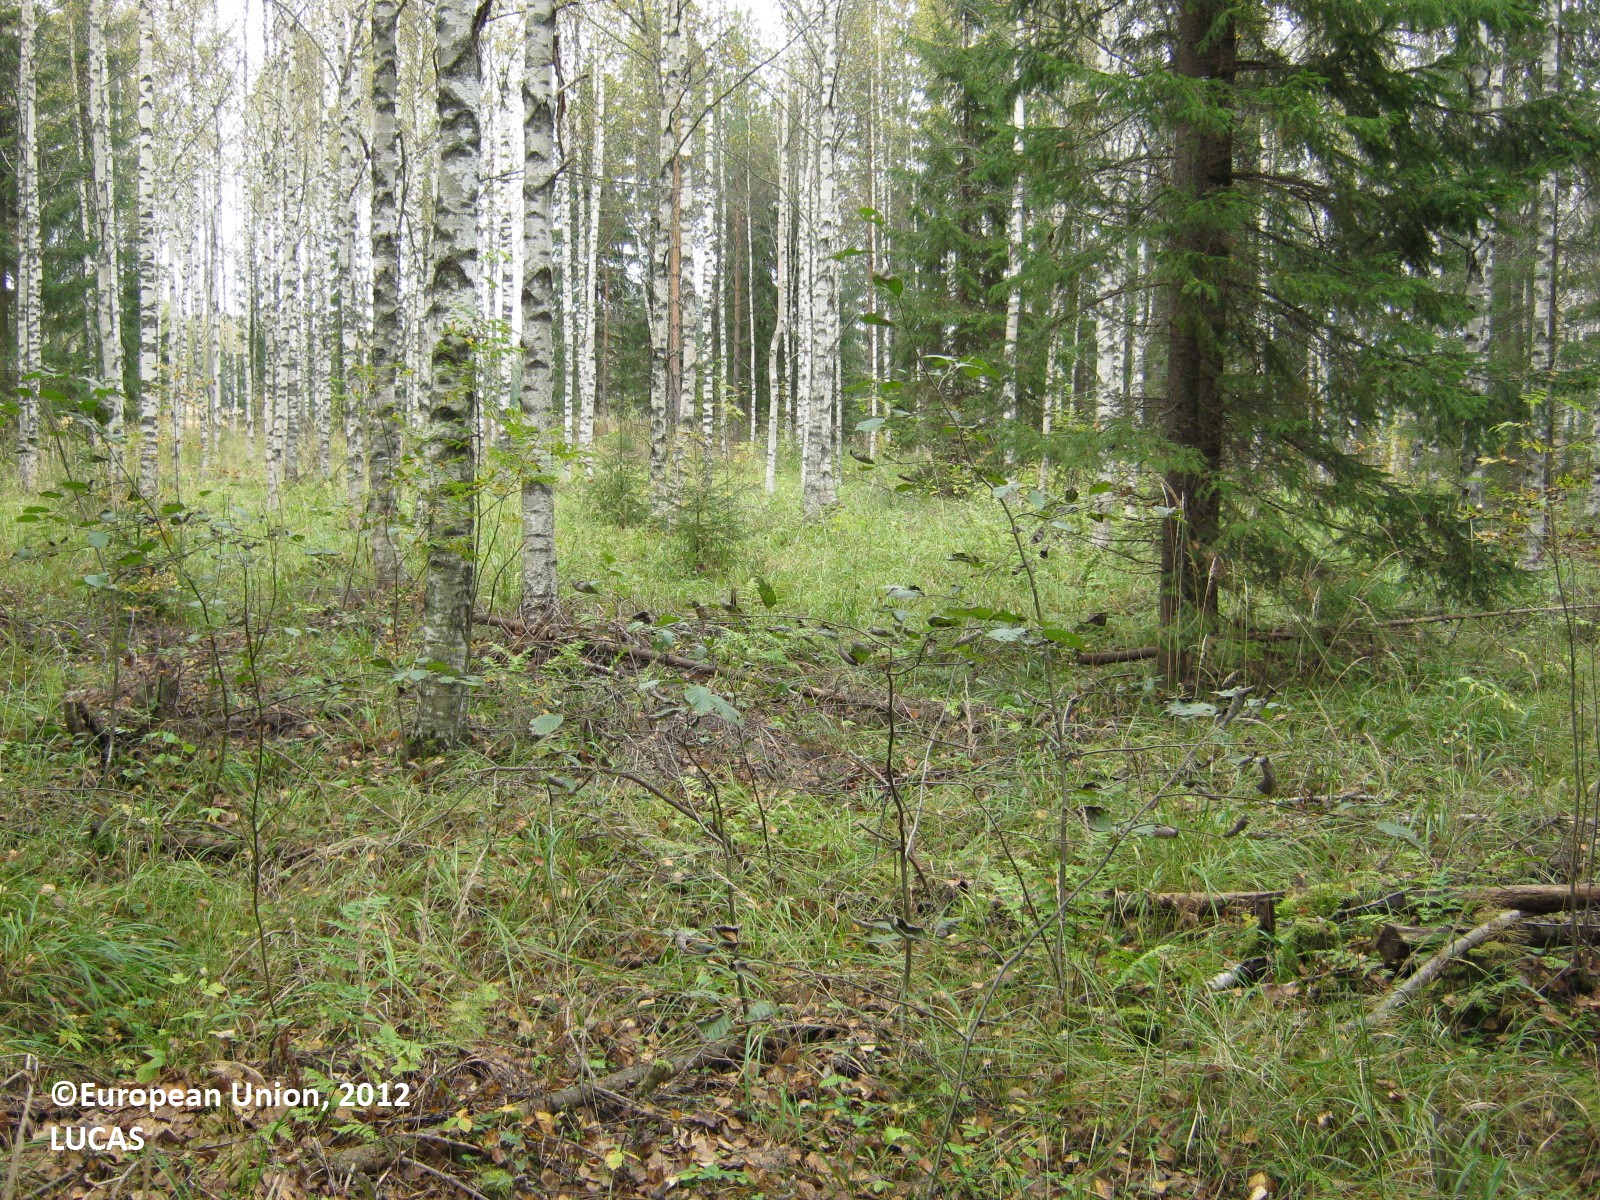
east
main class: Woodland
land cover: Other mixed woodland
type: boreal forest
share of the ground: > 75 %
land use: Forestry
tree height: > 5 m
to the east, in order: Other mixed woodland; Broadleaved woodland; Ditches and canals; Other leguminous and mixtures for fodder; Electric lines; Other leguminous and mixtures for fodder; Shruby margins; Ditches and canals; Shruby margins; Common wheat; Electric lines; Common wheat
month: September
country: FI
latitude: 61.0047
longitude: 28.0468
